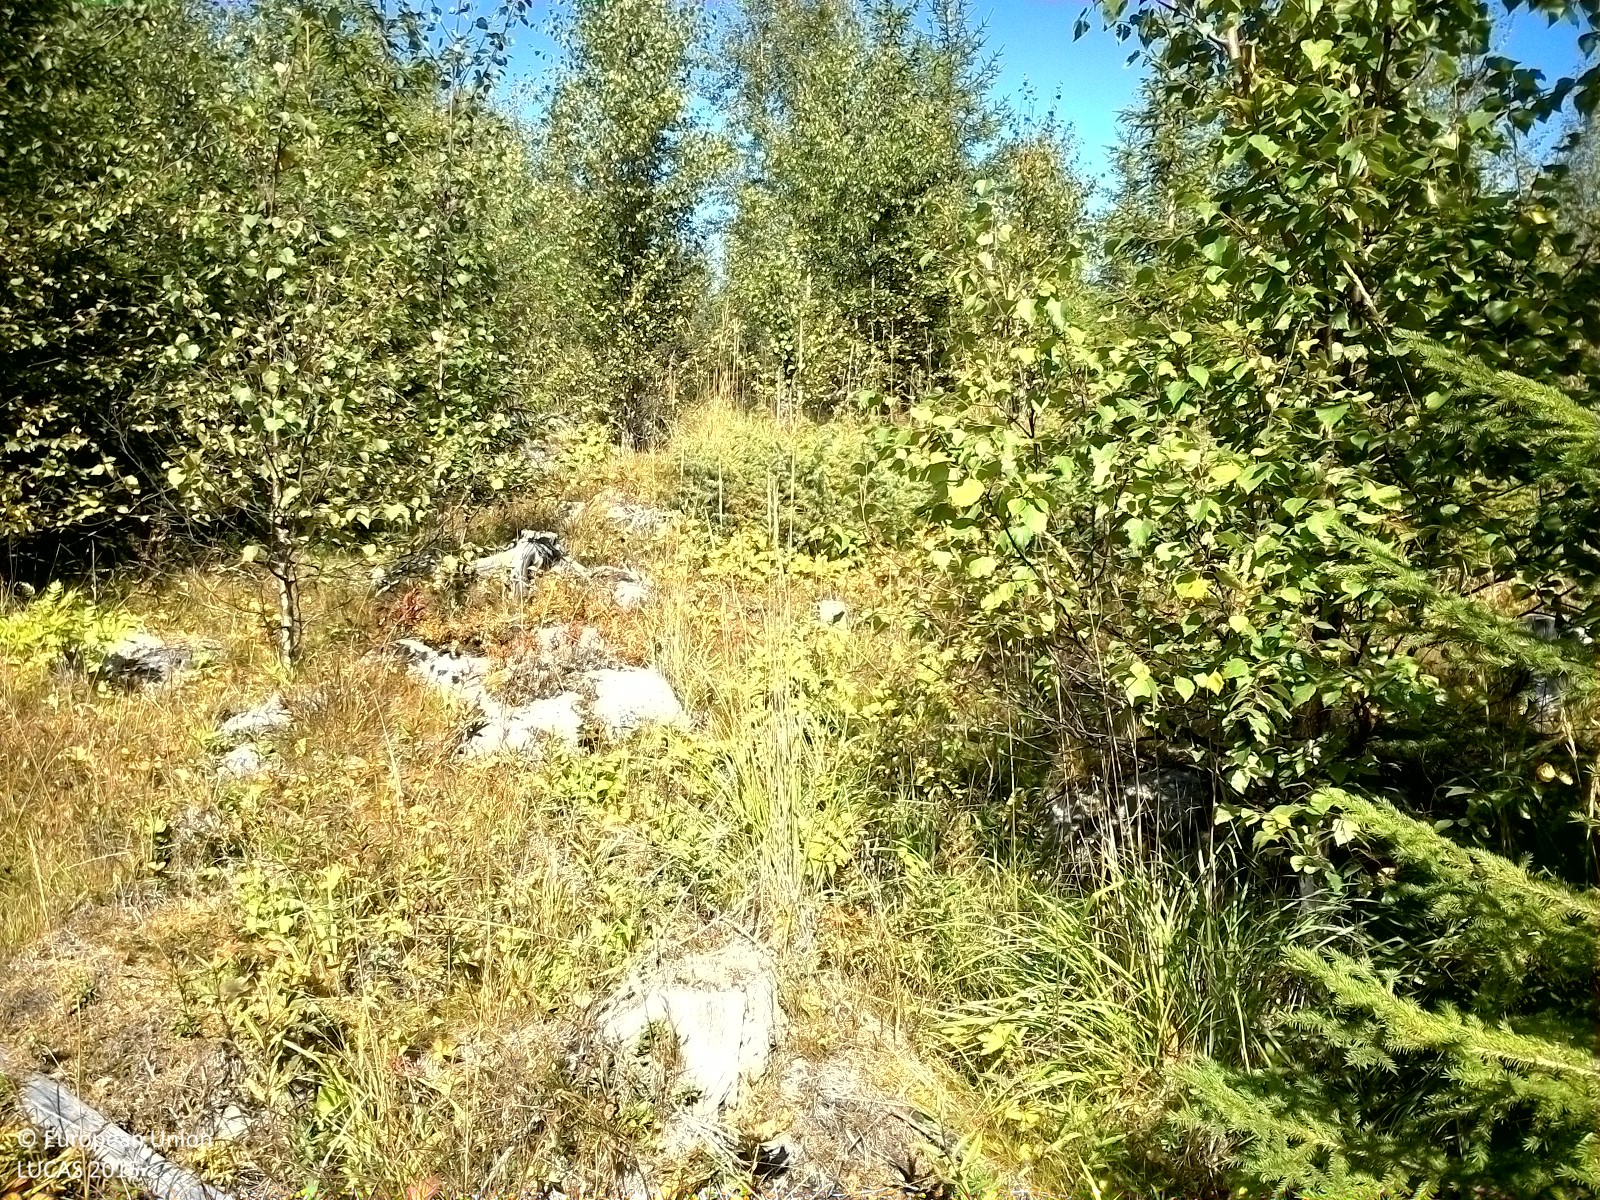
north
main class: Woodland
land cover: Spruce dominated mixed woodland
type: boreal forest
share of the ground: 25 - 50 %
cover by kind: herbaceous plants 60 %, coniferous forest trees 20 %, broadleaved forest trees 20 %
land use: Forestry
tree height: < 5 m
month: September
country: SE
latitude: 62.5872
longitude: 16.3452
